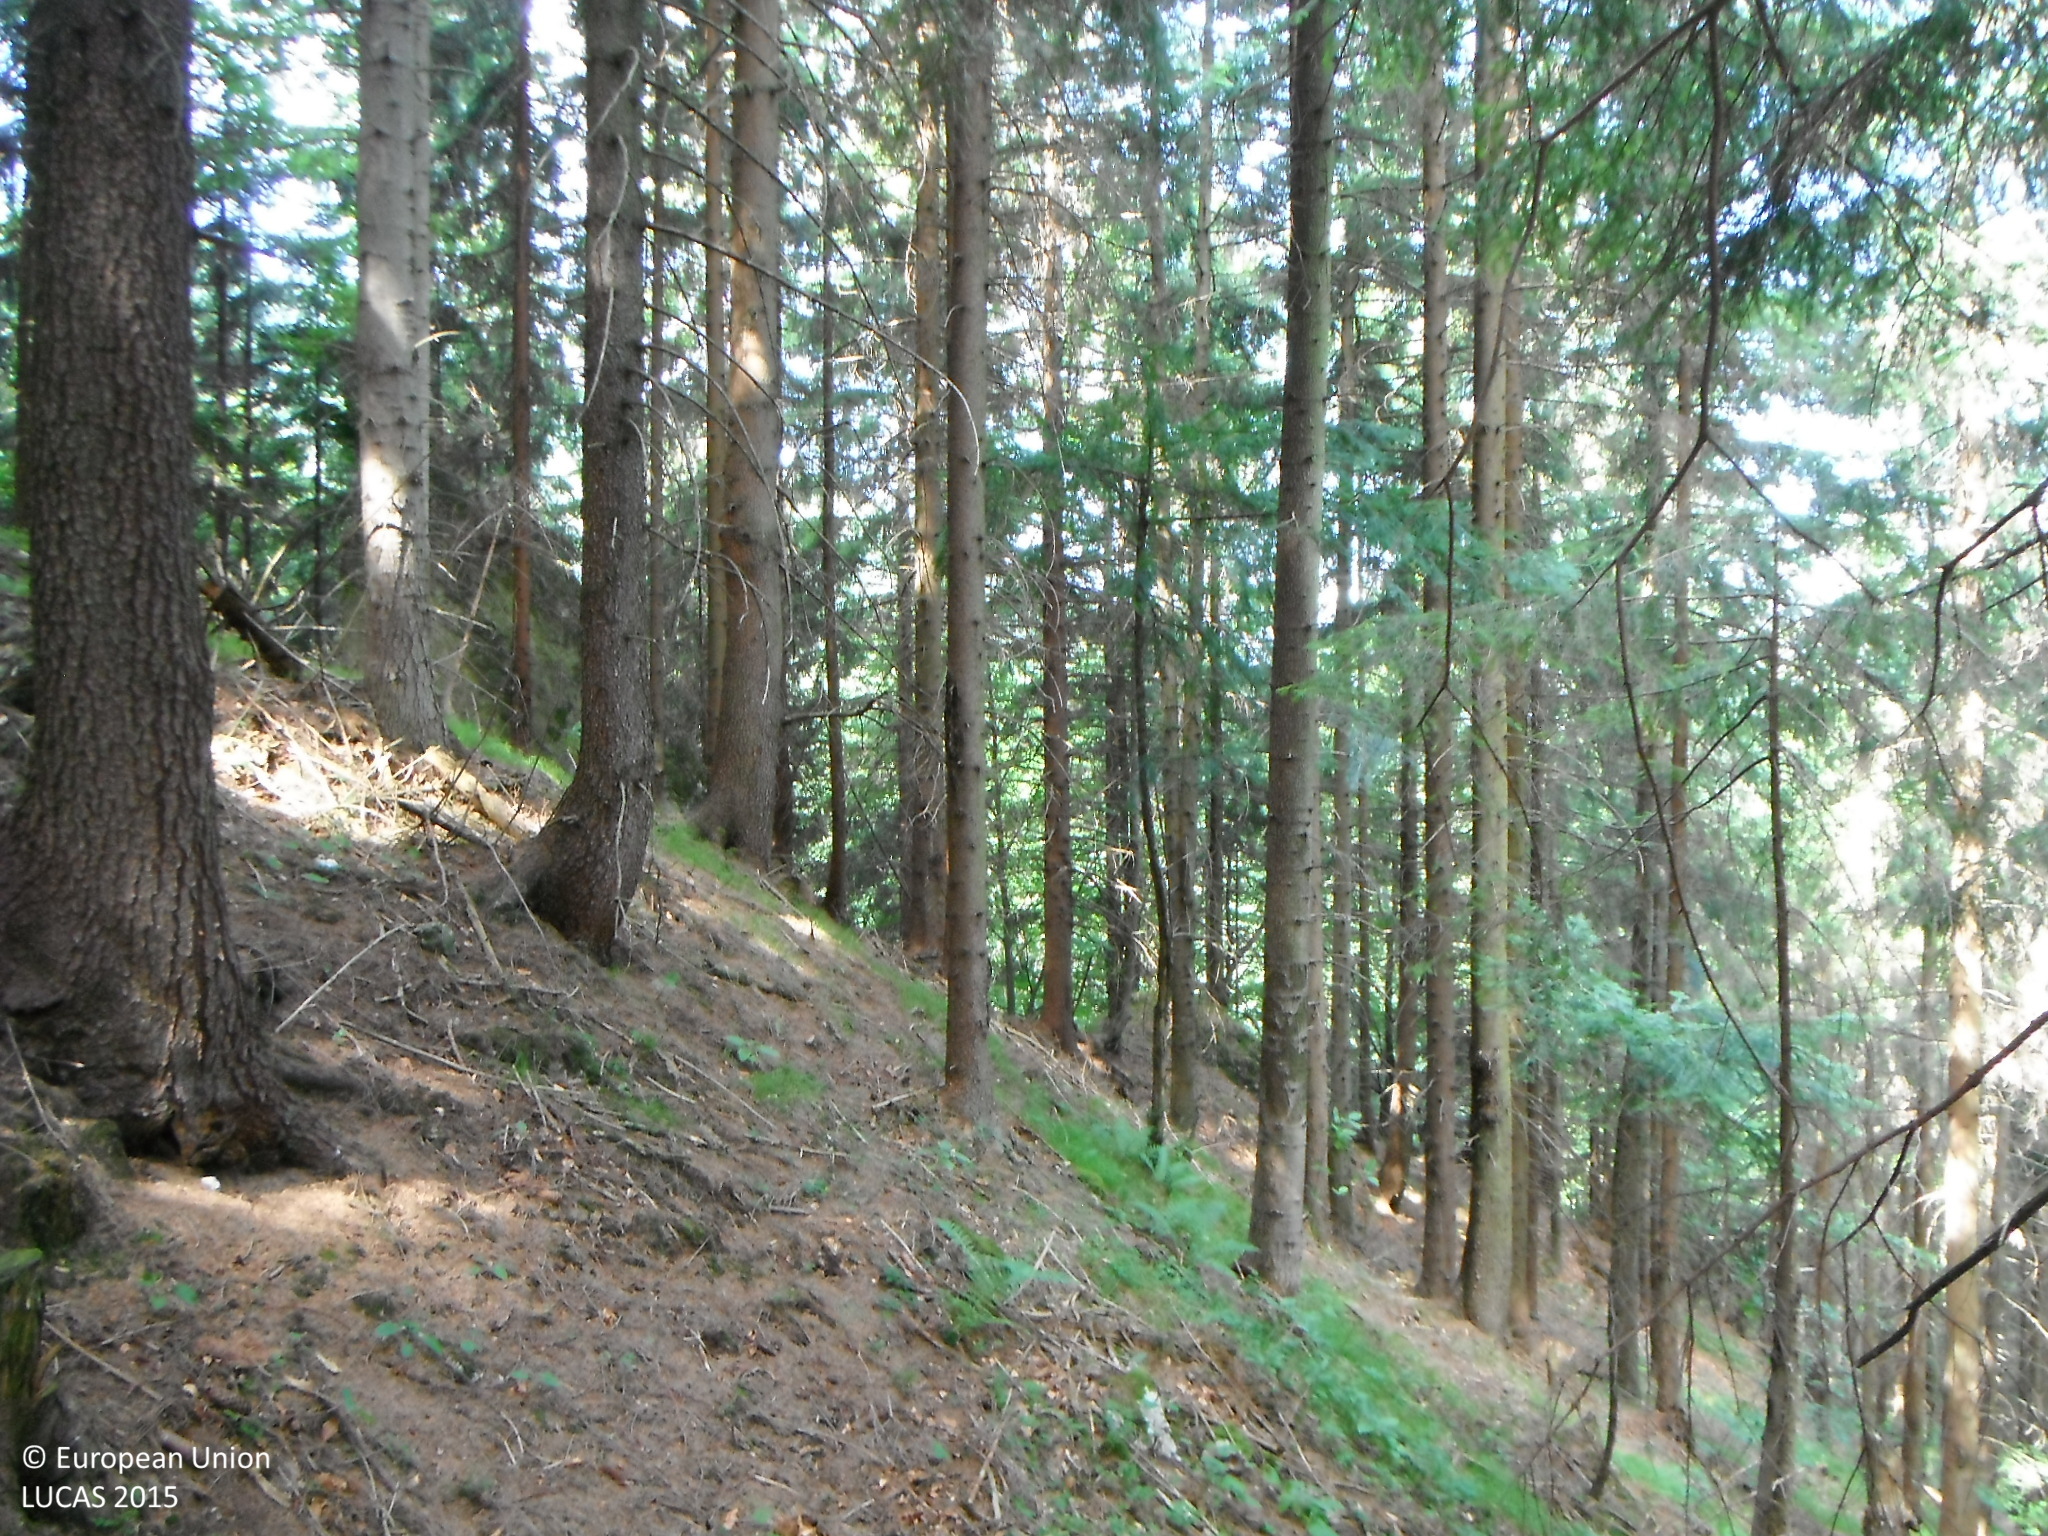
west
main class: Woodland
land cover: Spruce dominated coniferous woodland
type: alpine coniferous forest
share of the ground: > 75 %
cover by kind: coniferous forest trees 95 %, broadleaved forest trees 5 %
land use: Forestry
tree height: > 5 m
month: July
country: SK
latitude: 49.2560
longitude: 19.1324
